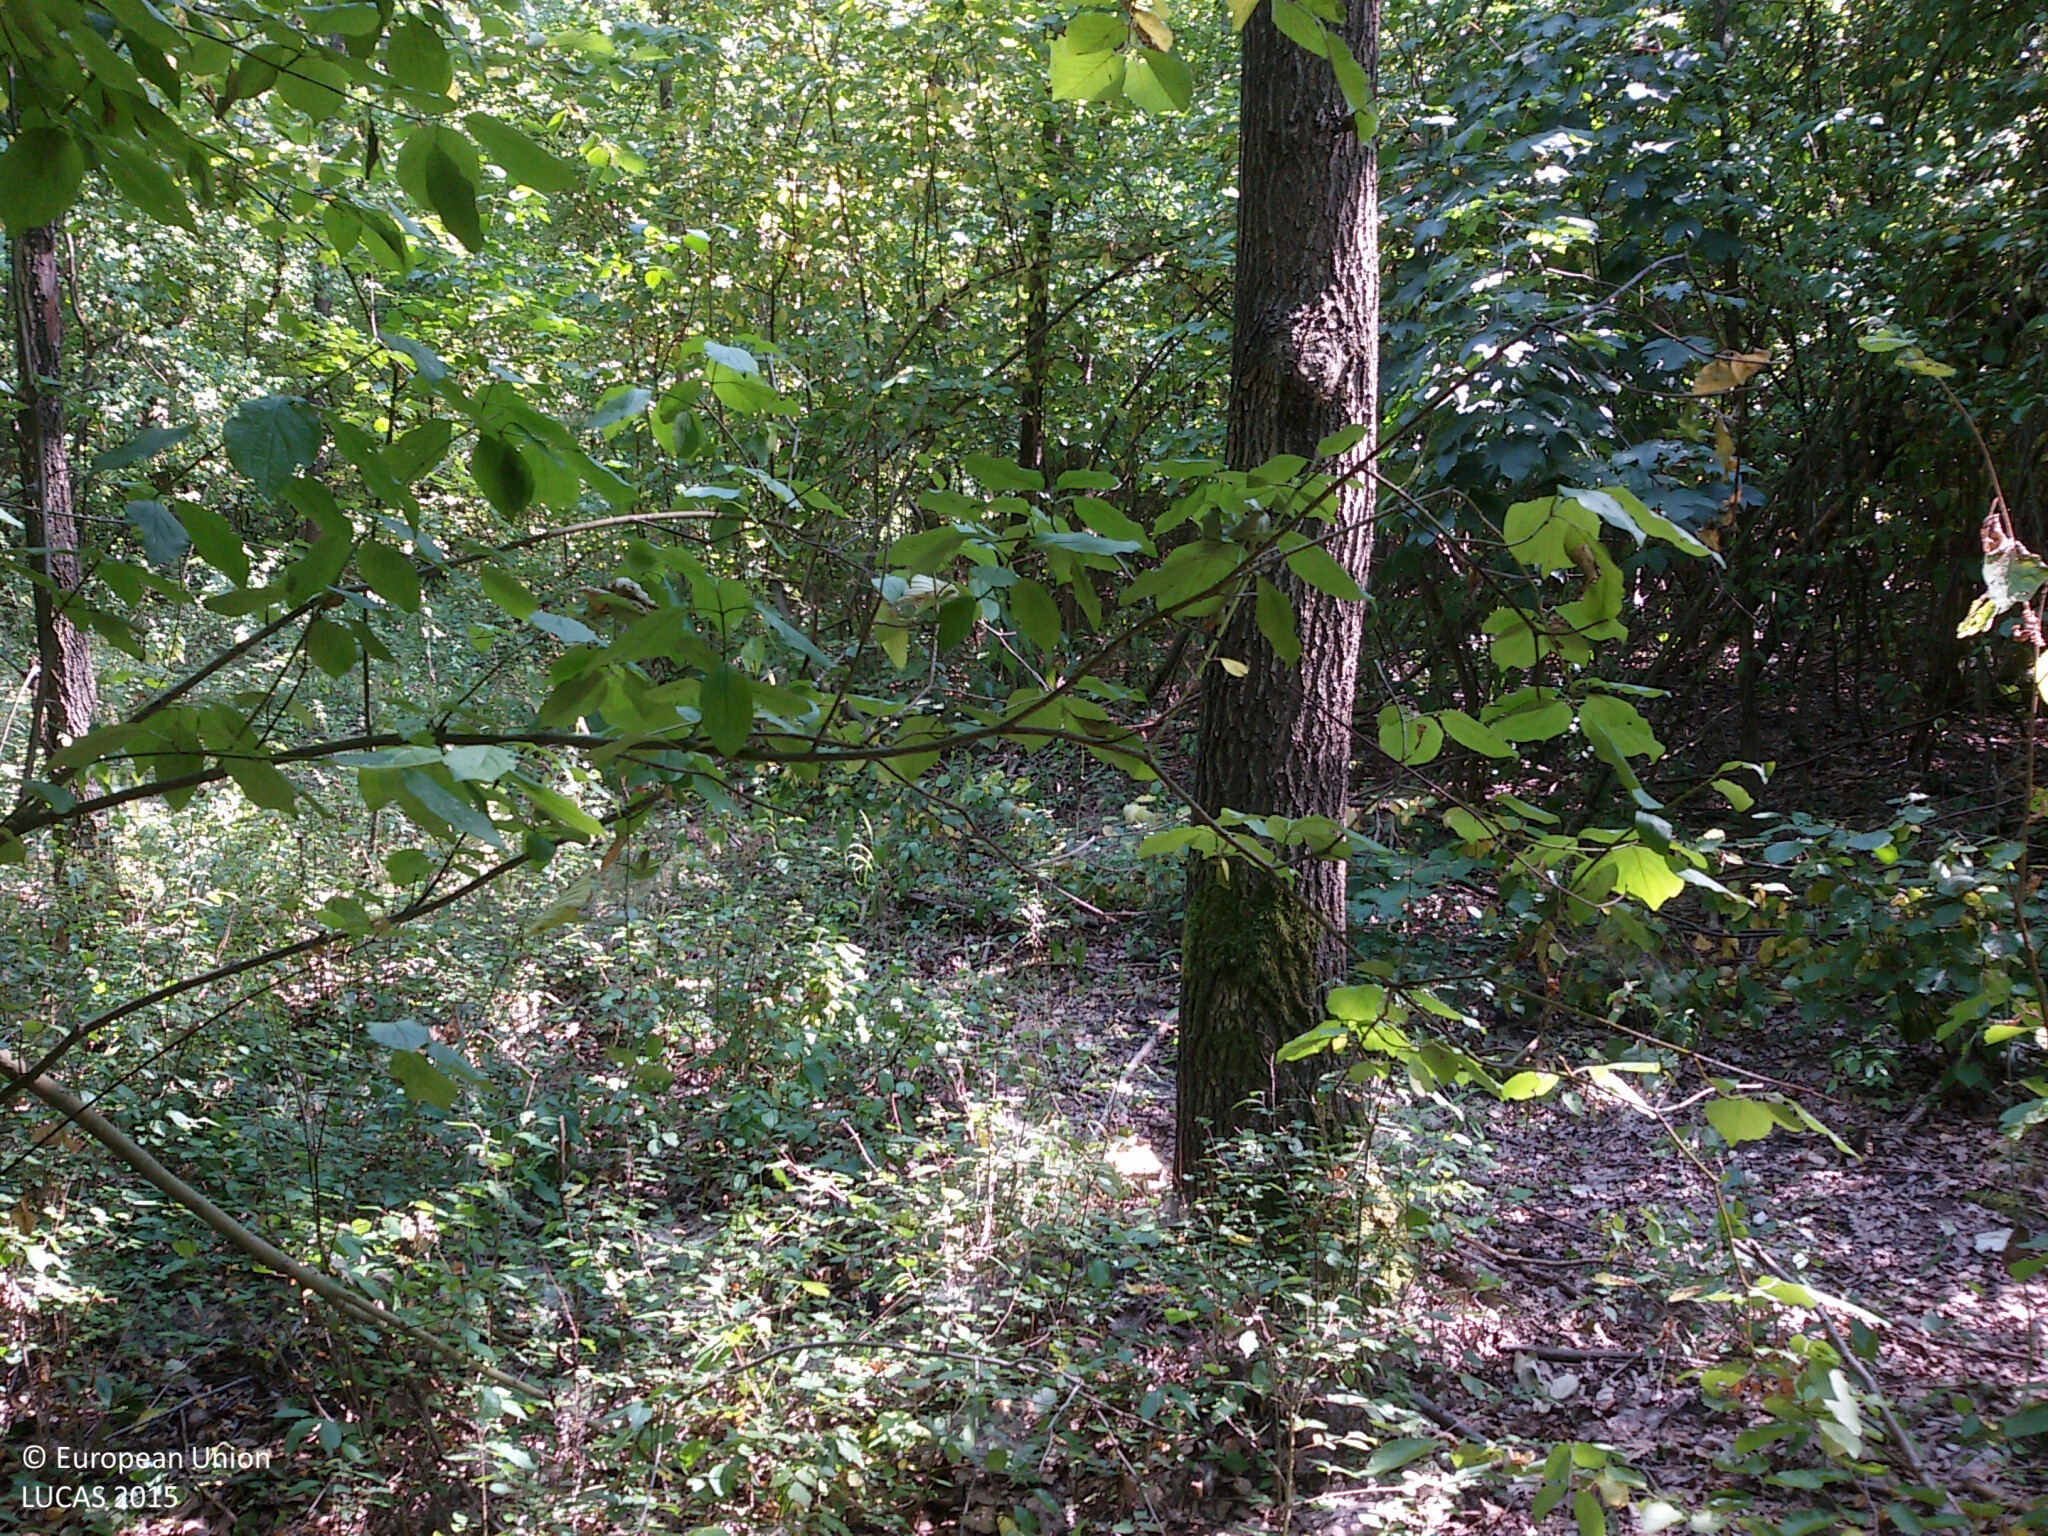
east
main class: Woodland
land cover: Broadleaved woodland
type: mesophytic deciduous forest
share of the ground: > 75 %
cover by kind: broadleaved forest trees 90 %, shrubs 5 %, unconsolidated bare surface 5 %
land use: Forestry
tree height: > 5 m
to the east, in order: Broadleaved woodland; Tracks; Broadleaved woodland; Tracks; Broadleaved woodland; Tracks; Broadleaved woodland
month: August
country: PL
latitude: 52.7040
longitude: 20.9507
